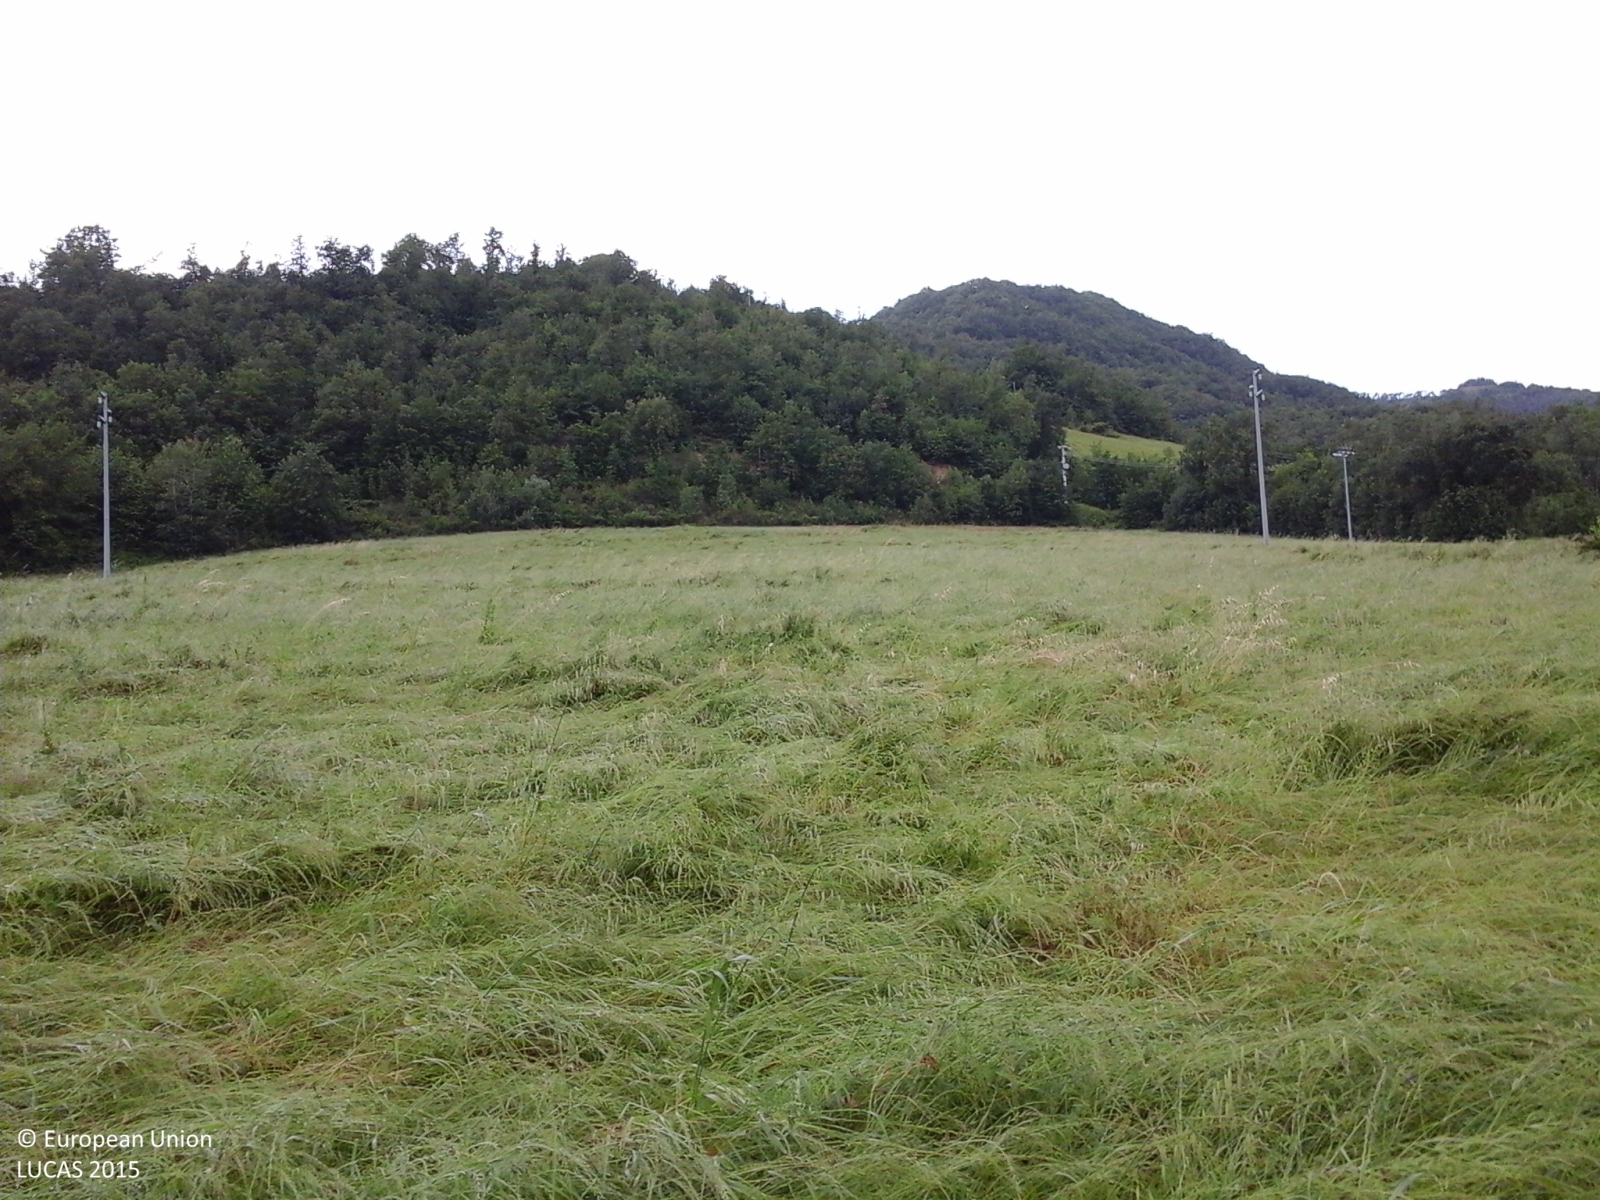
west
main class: Cropland
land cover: Other leguminous and mixtures for fodder
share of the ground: > 75 %
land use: Agriculture (excluding fallow land and kitchen gardens)
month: May
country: IT
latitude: 44.0444
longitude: 11.9049
